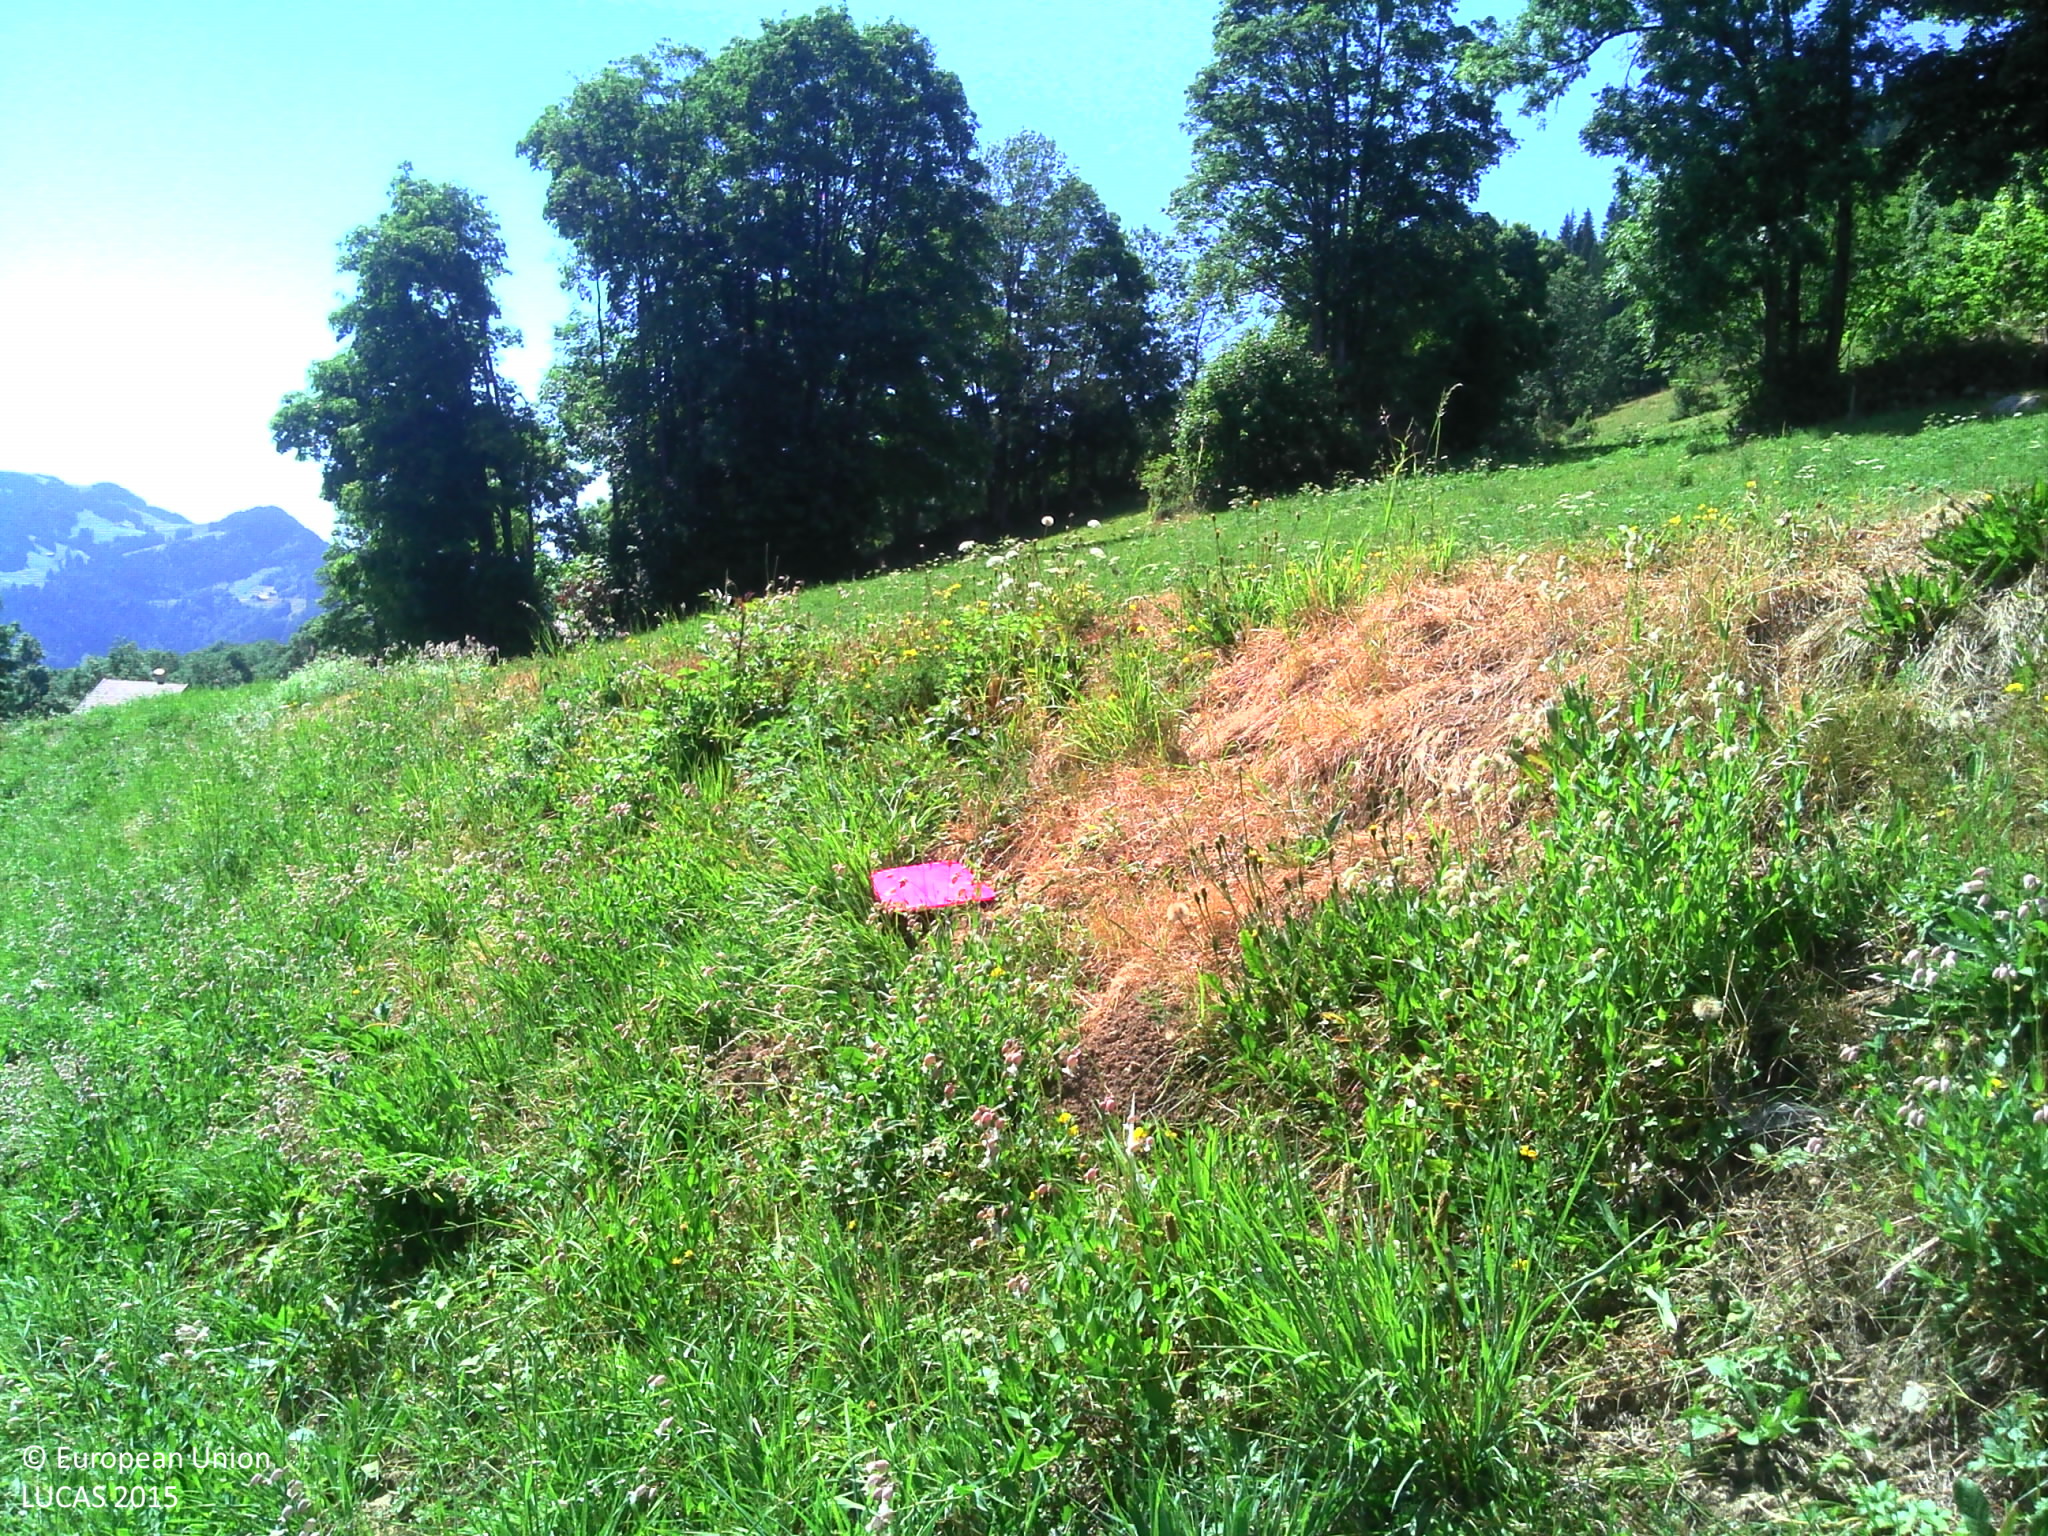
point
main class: Grassland
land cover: Grassland with sparse tree/shrub cover
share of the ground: > 75 %
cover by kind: herbaceous plants 95 %, broadleaved forest trees 5 %
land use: Agriculture (excluding fallow land and kitchen gardens)
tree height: > 5 m
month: July
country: FR
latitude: 45.9139
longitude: 6.4585
